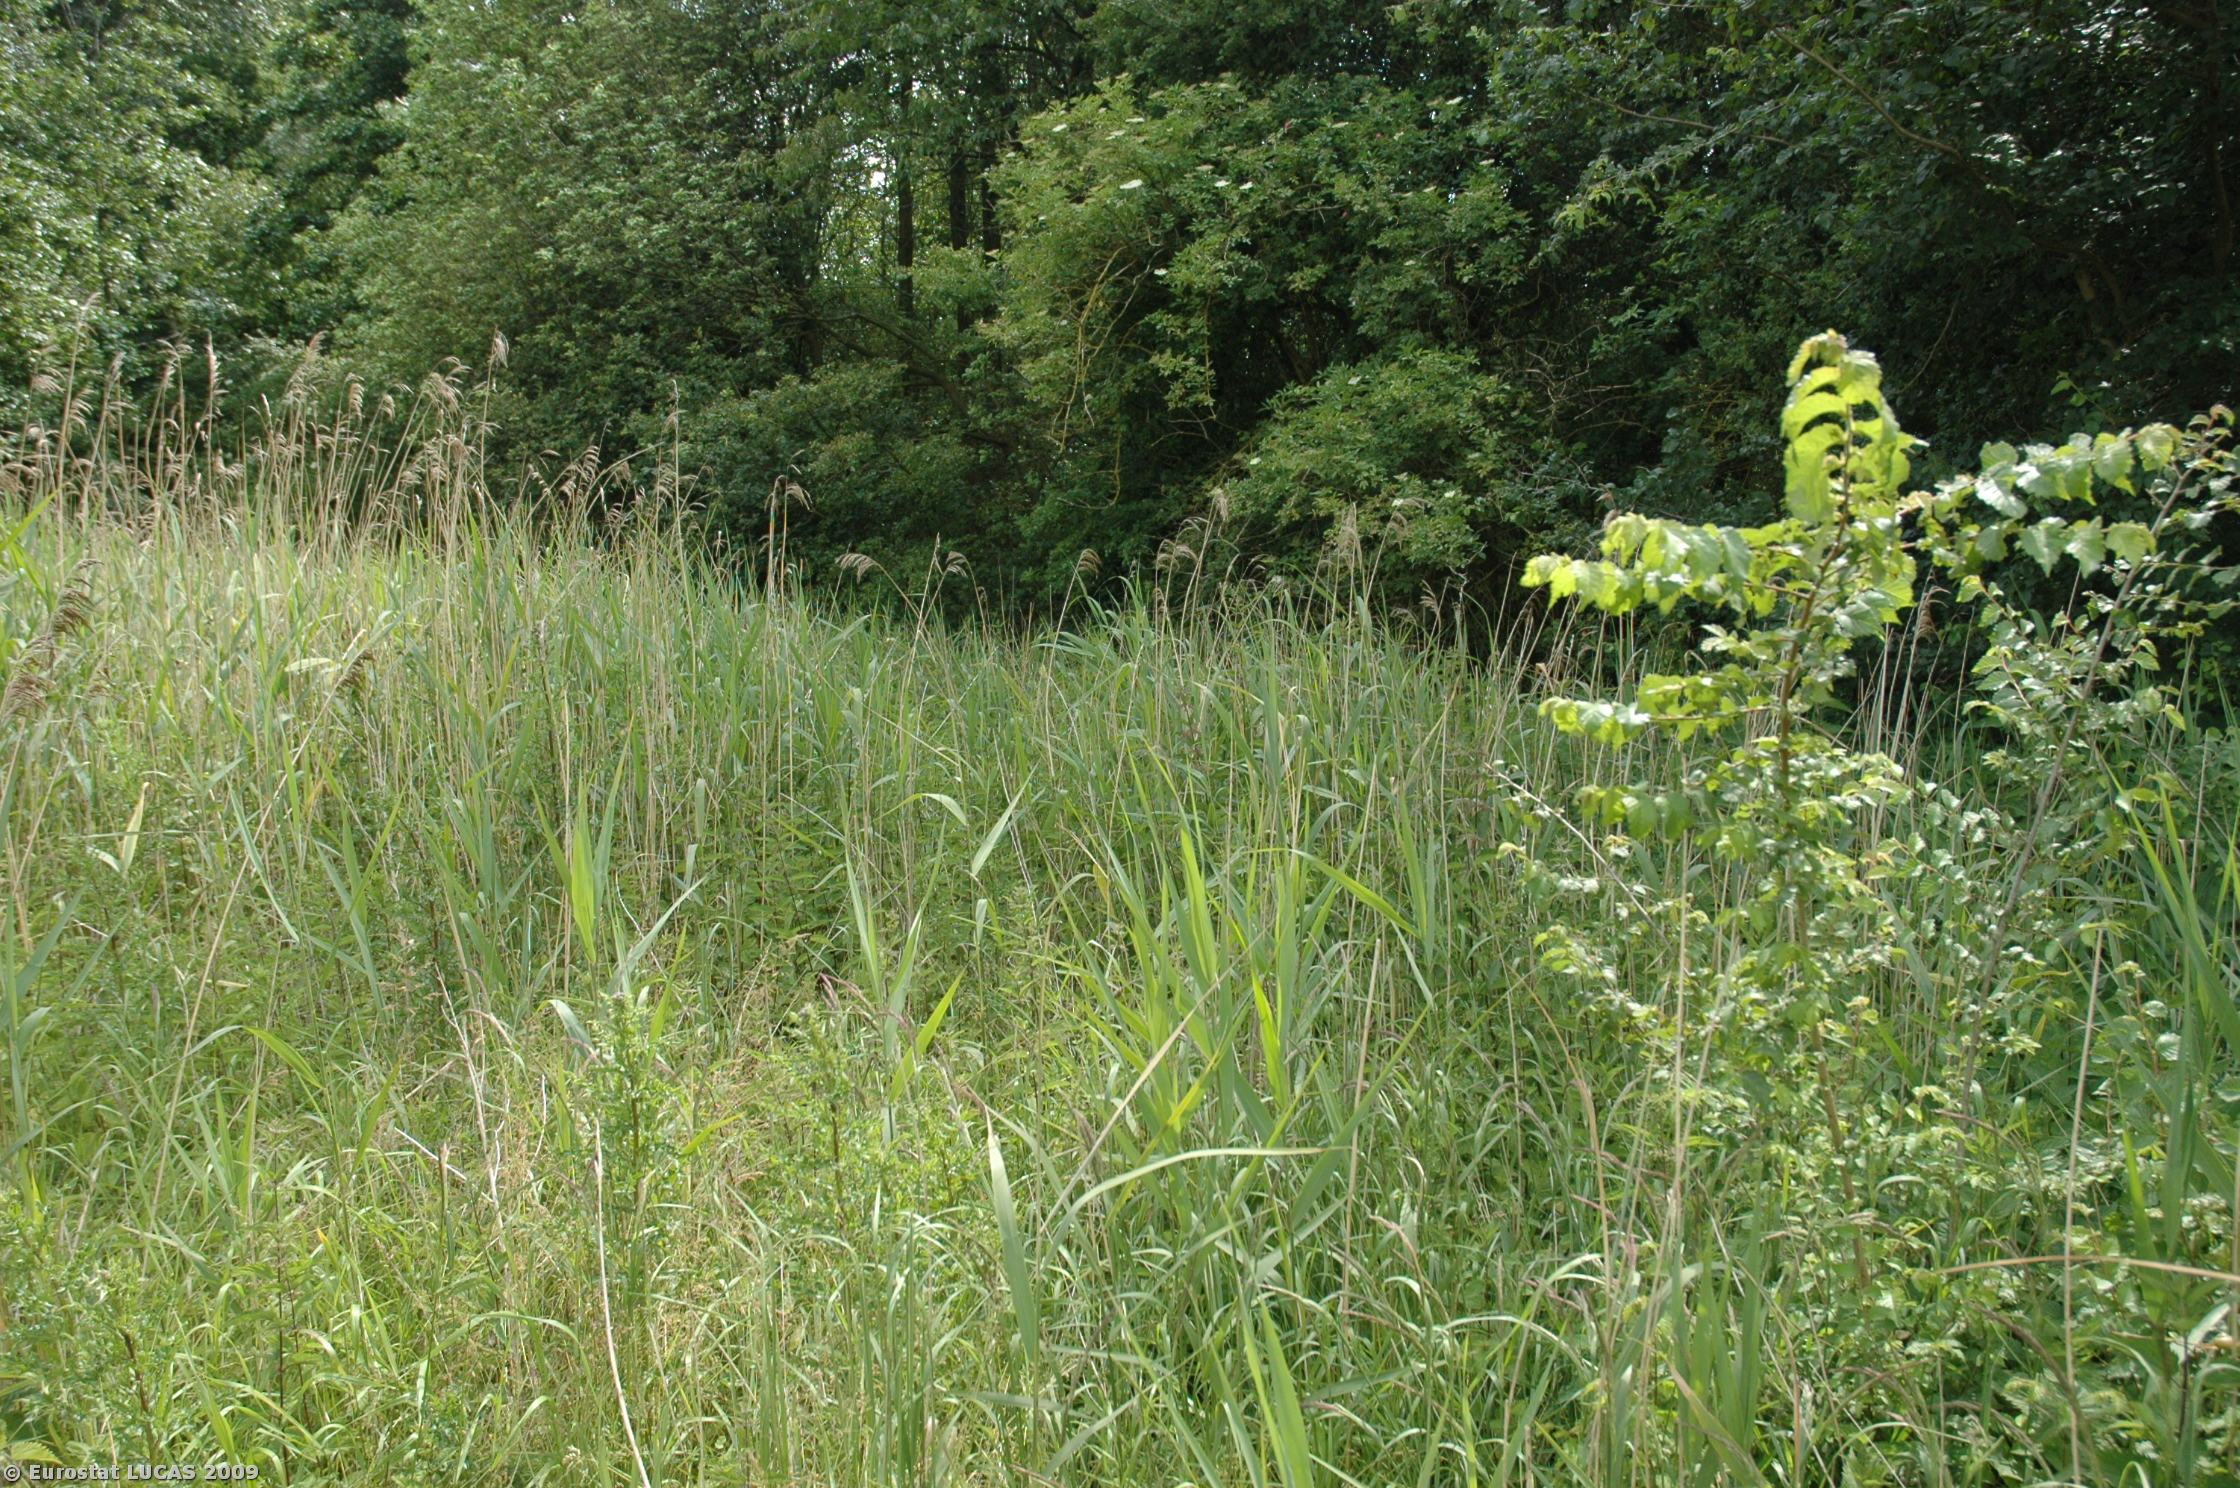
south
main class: Woodland
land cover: Broadleaved woodland
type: non-riverine alder, birch or aspen forest
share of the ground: > 75 %
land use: Unused
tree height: > 5 m
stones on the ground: < 10 %
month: June
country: NL
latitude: 52.6036
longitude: 5.6429
